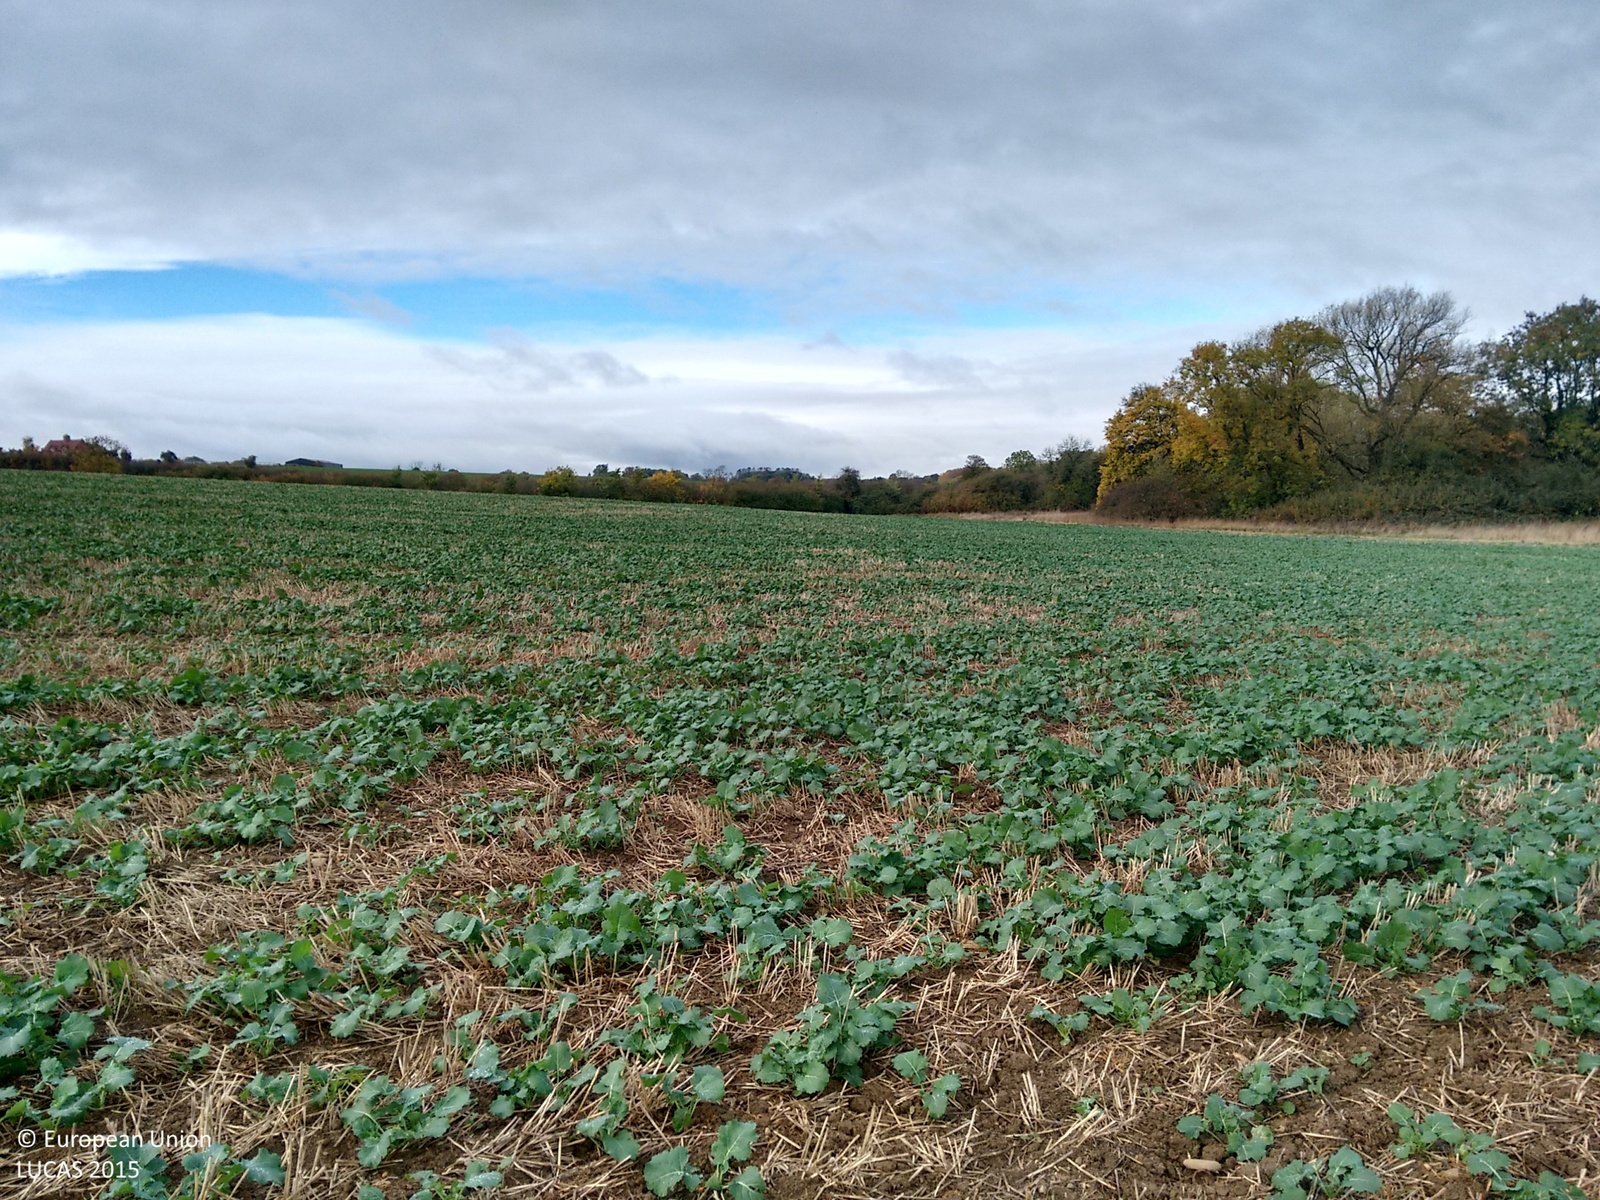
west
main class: Cropland
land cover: Rape and turnip rape
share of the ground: 50 - 75 %
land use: Agriculture (excluding fallow land and kitchen gardens)
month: October
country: GB
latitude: 52.0356
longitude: -1.6718
